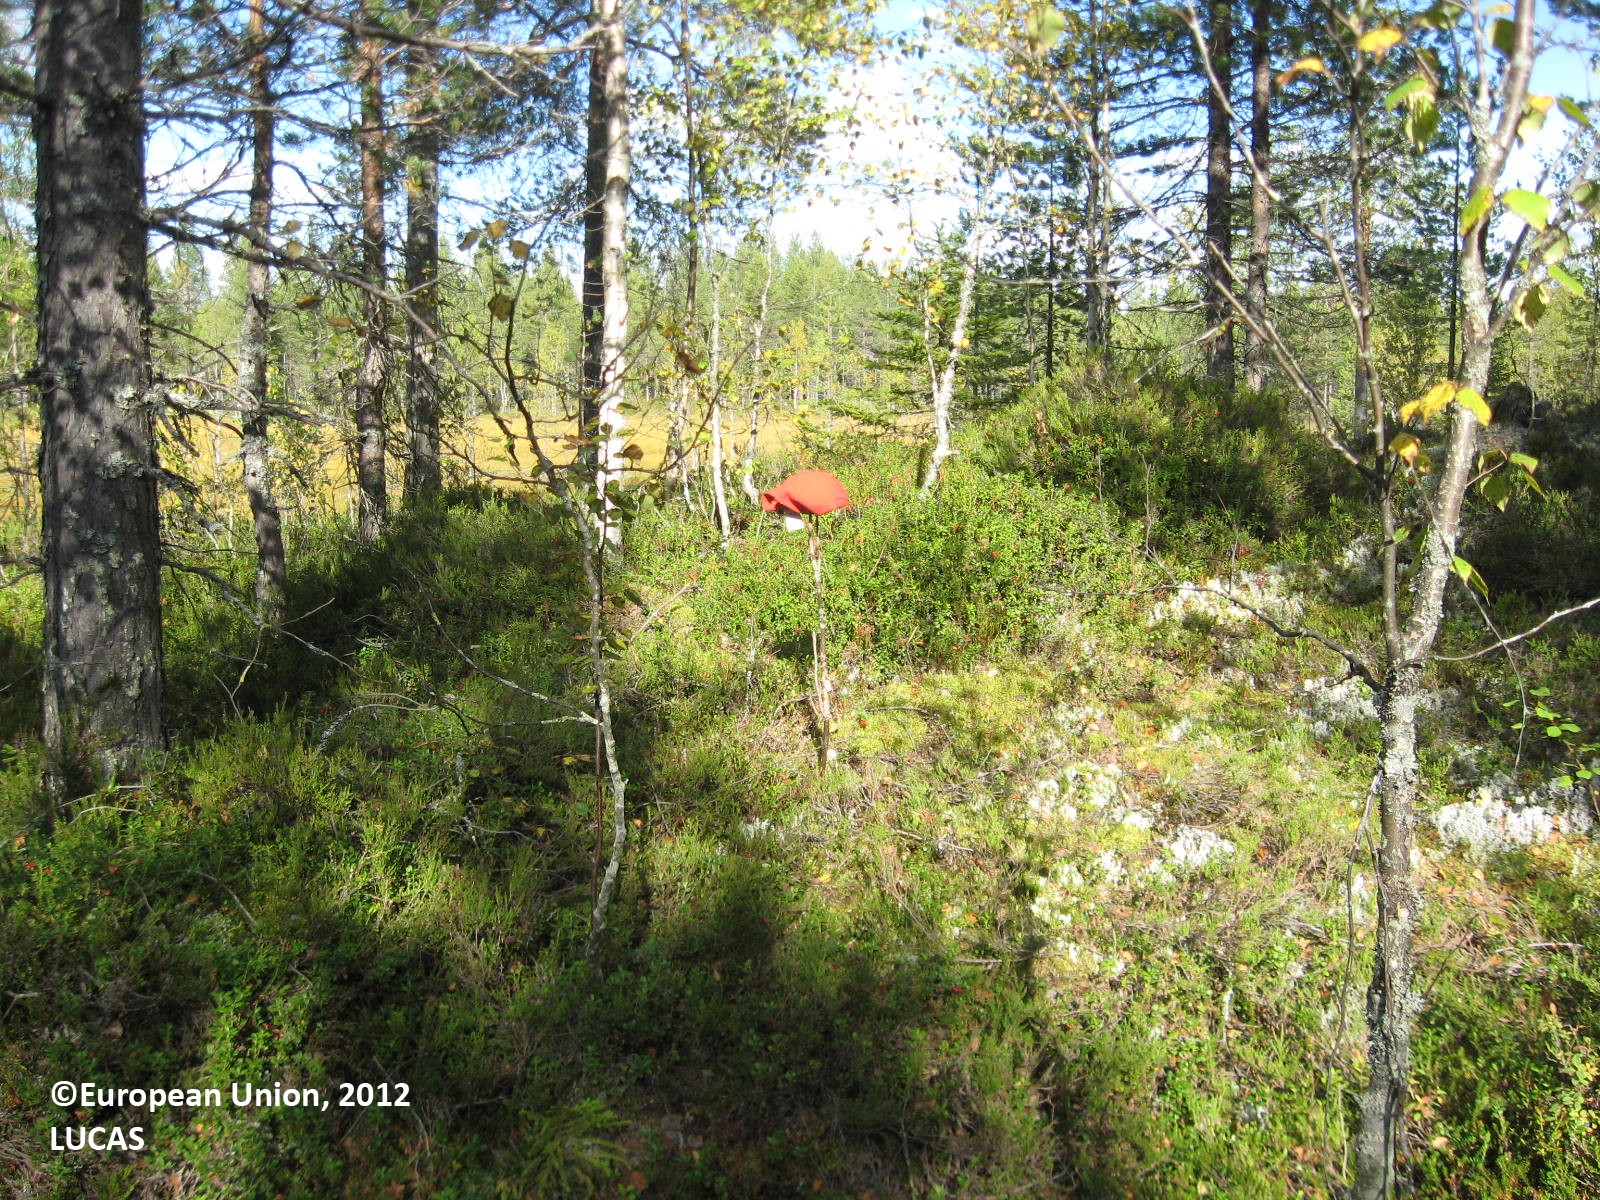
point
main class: Woodland
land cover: Pine dominated mixed woodland
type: boreal forest
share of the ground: > 75 %
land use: Forestry
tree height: > 5 m
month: August
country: FI
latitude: 63.8474
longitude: 29.6061
